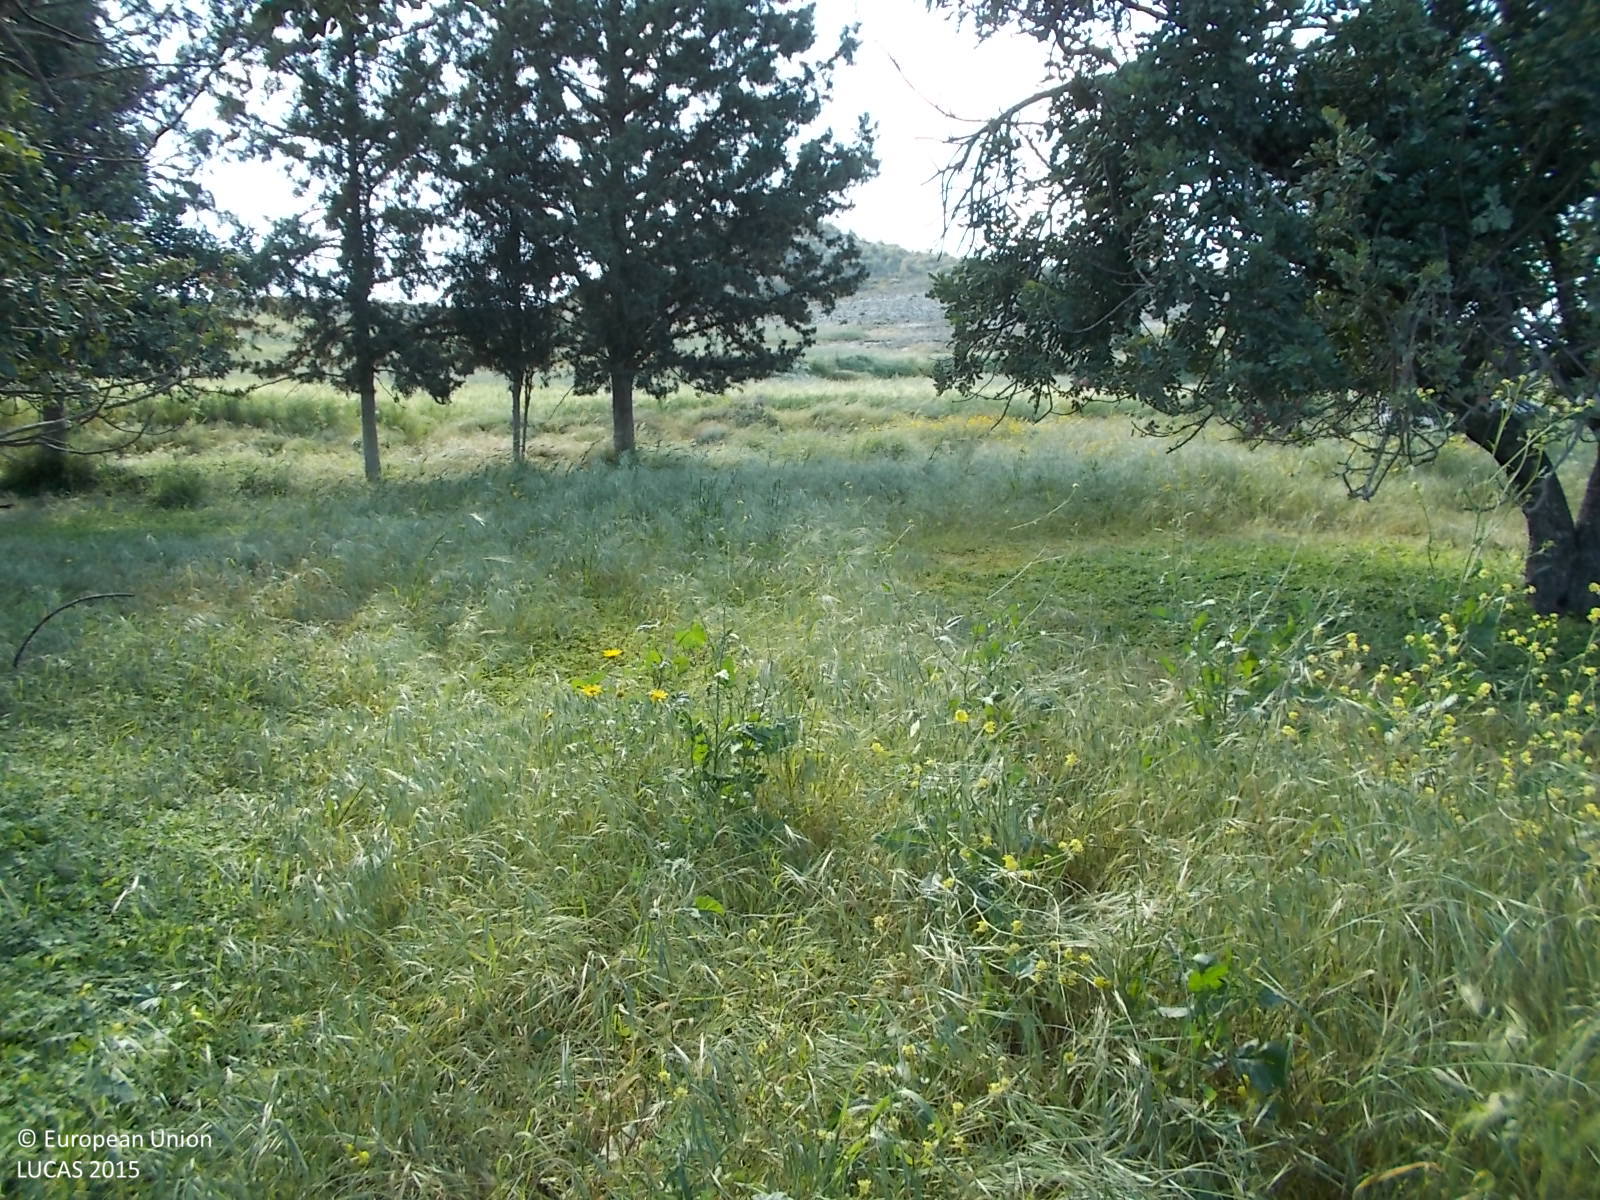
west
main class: Cropland
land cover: Other fruit trees and berries
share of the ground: 50 - 75 %
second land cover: Spontaneously vegetated surfaces
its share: > 75 %
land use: Agriculture (excluding fallow land and kitchen gardens)
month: April
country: CY
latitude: 34.9798
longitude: 33.5151
